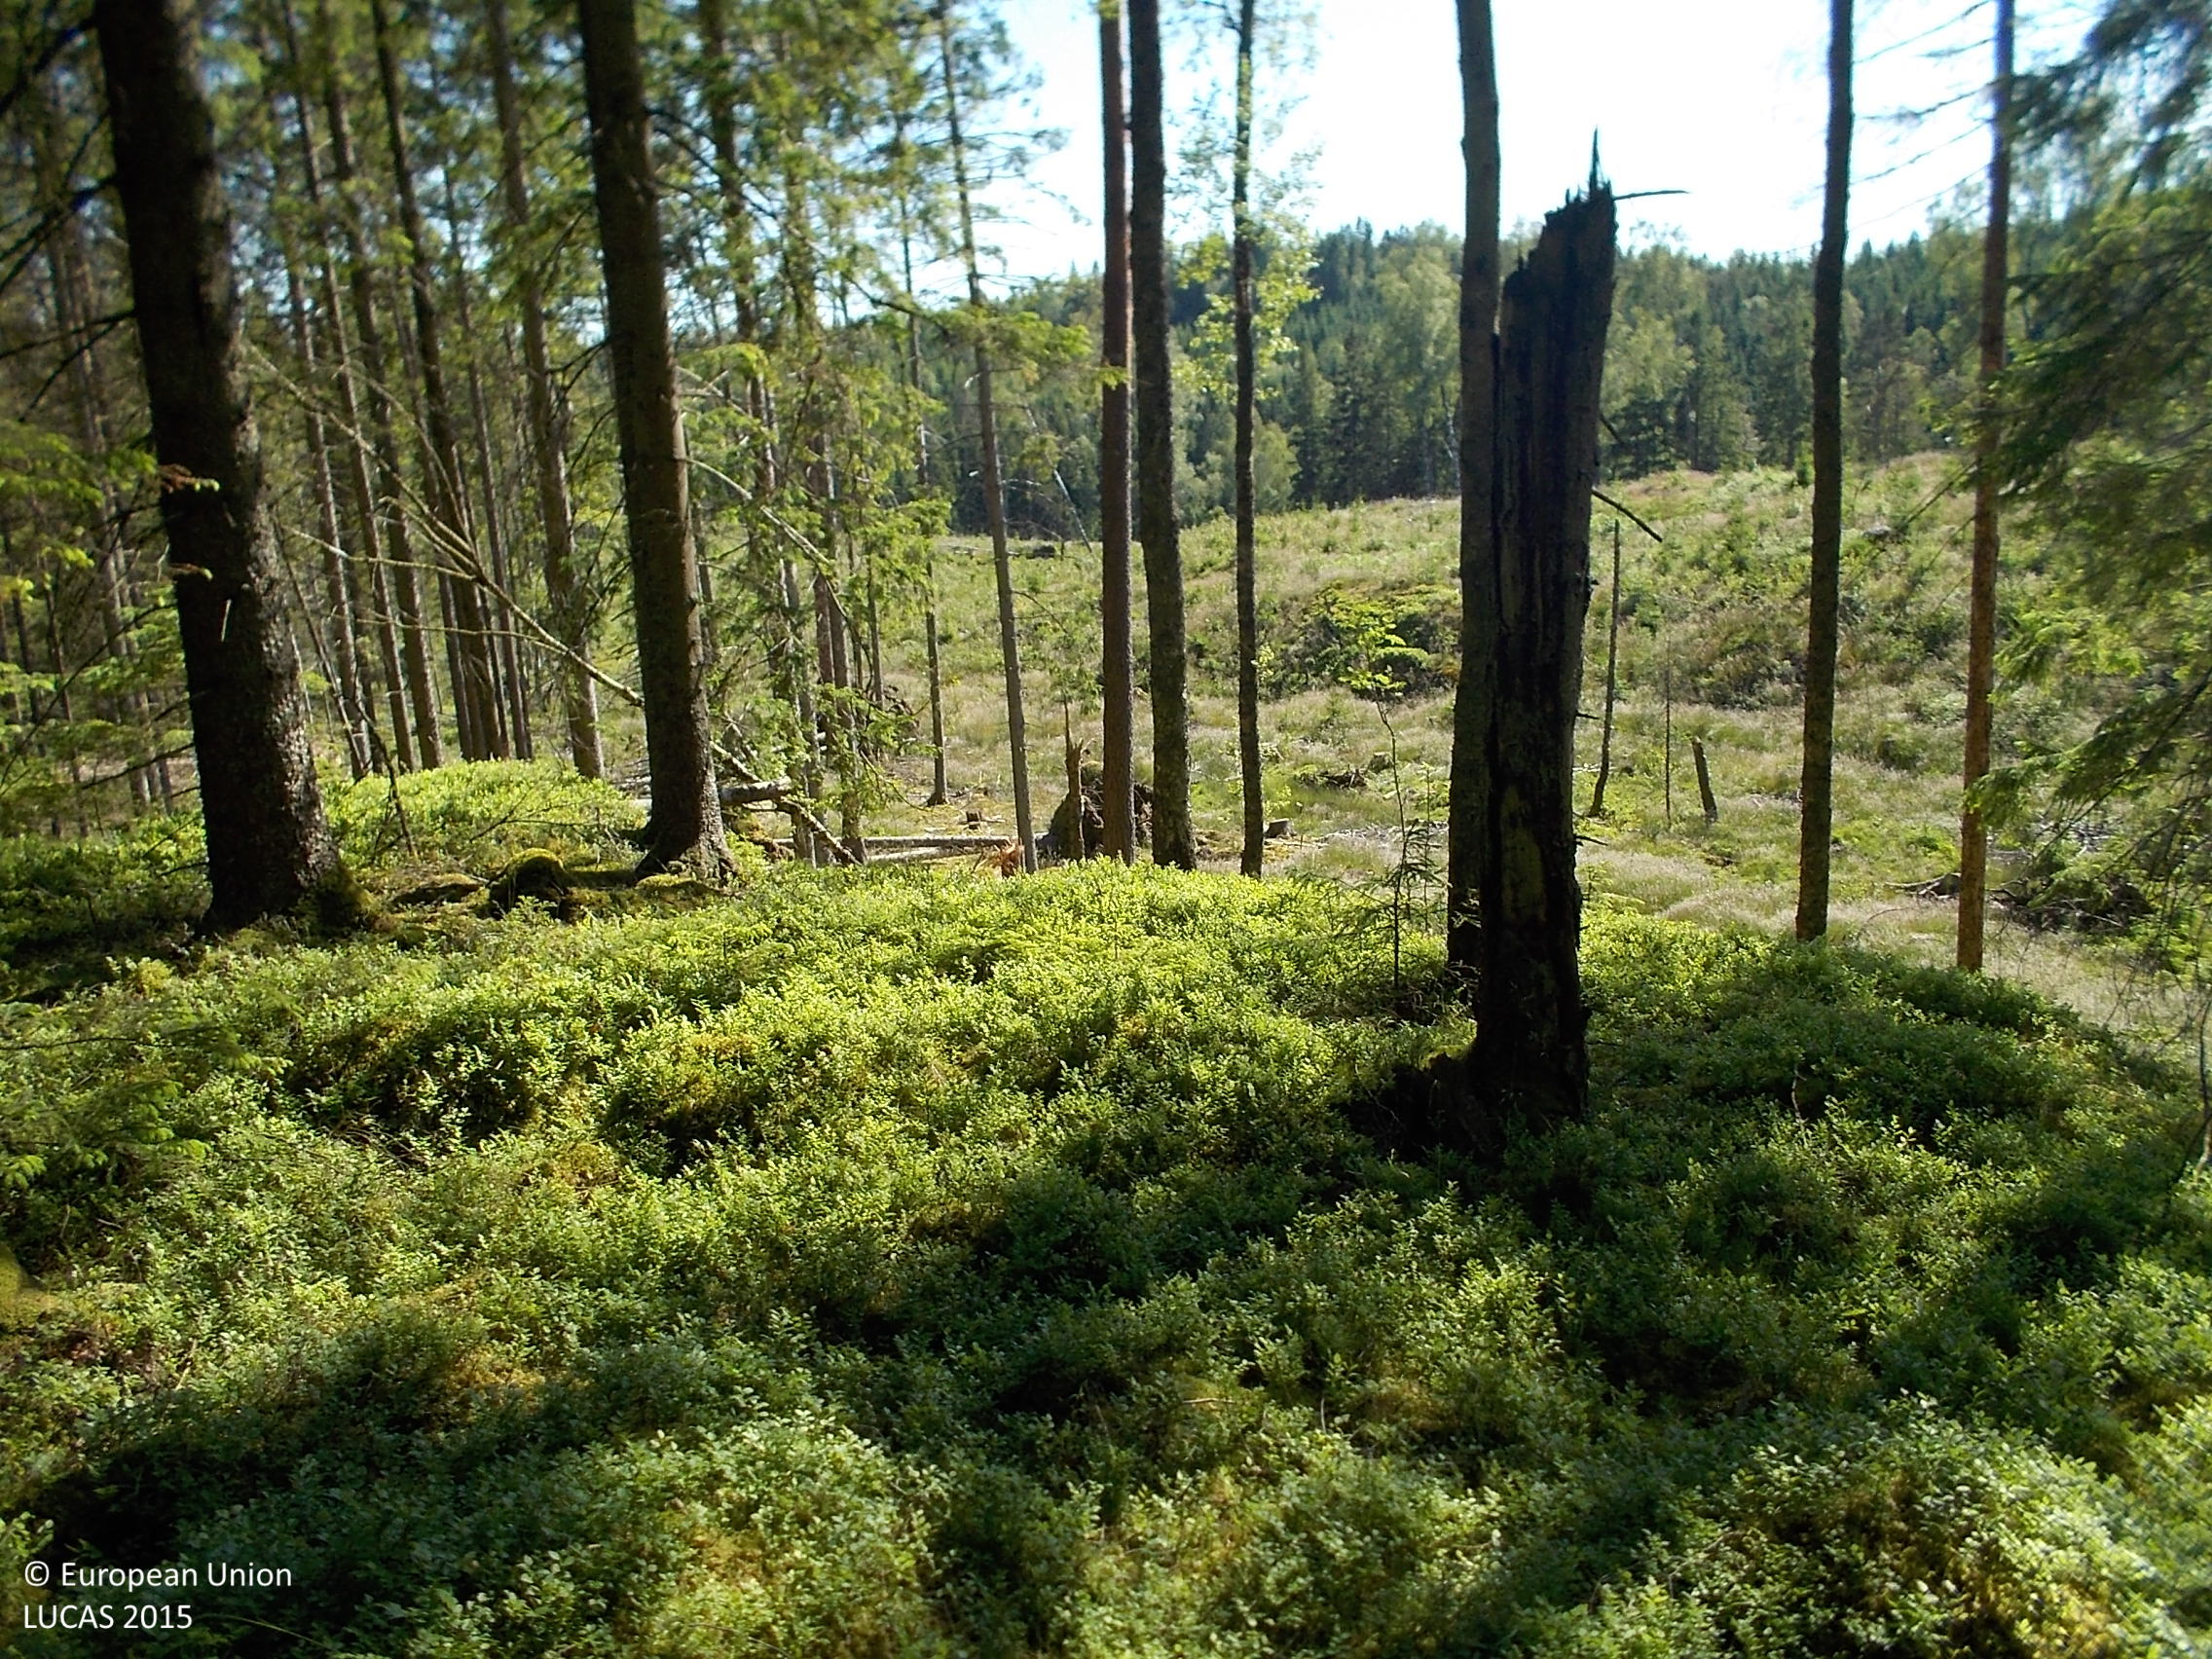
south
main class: Woodland
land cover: Spruce dominated coniferous woodland
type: boreal forest
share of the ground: 50 - 75 %
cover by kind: coniferous forest trees 70 %, shrubs 25 %, herbaceous plants 5 %
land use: Forestry
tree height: > 5 m
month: June
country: SE
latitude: 57.3566
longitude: 13.0710
